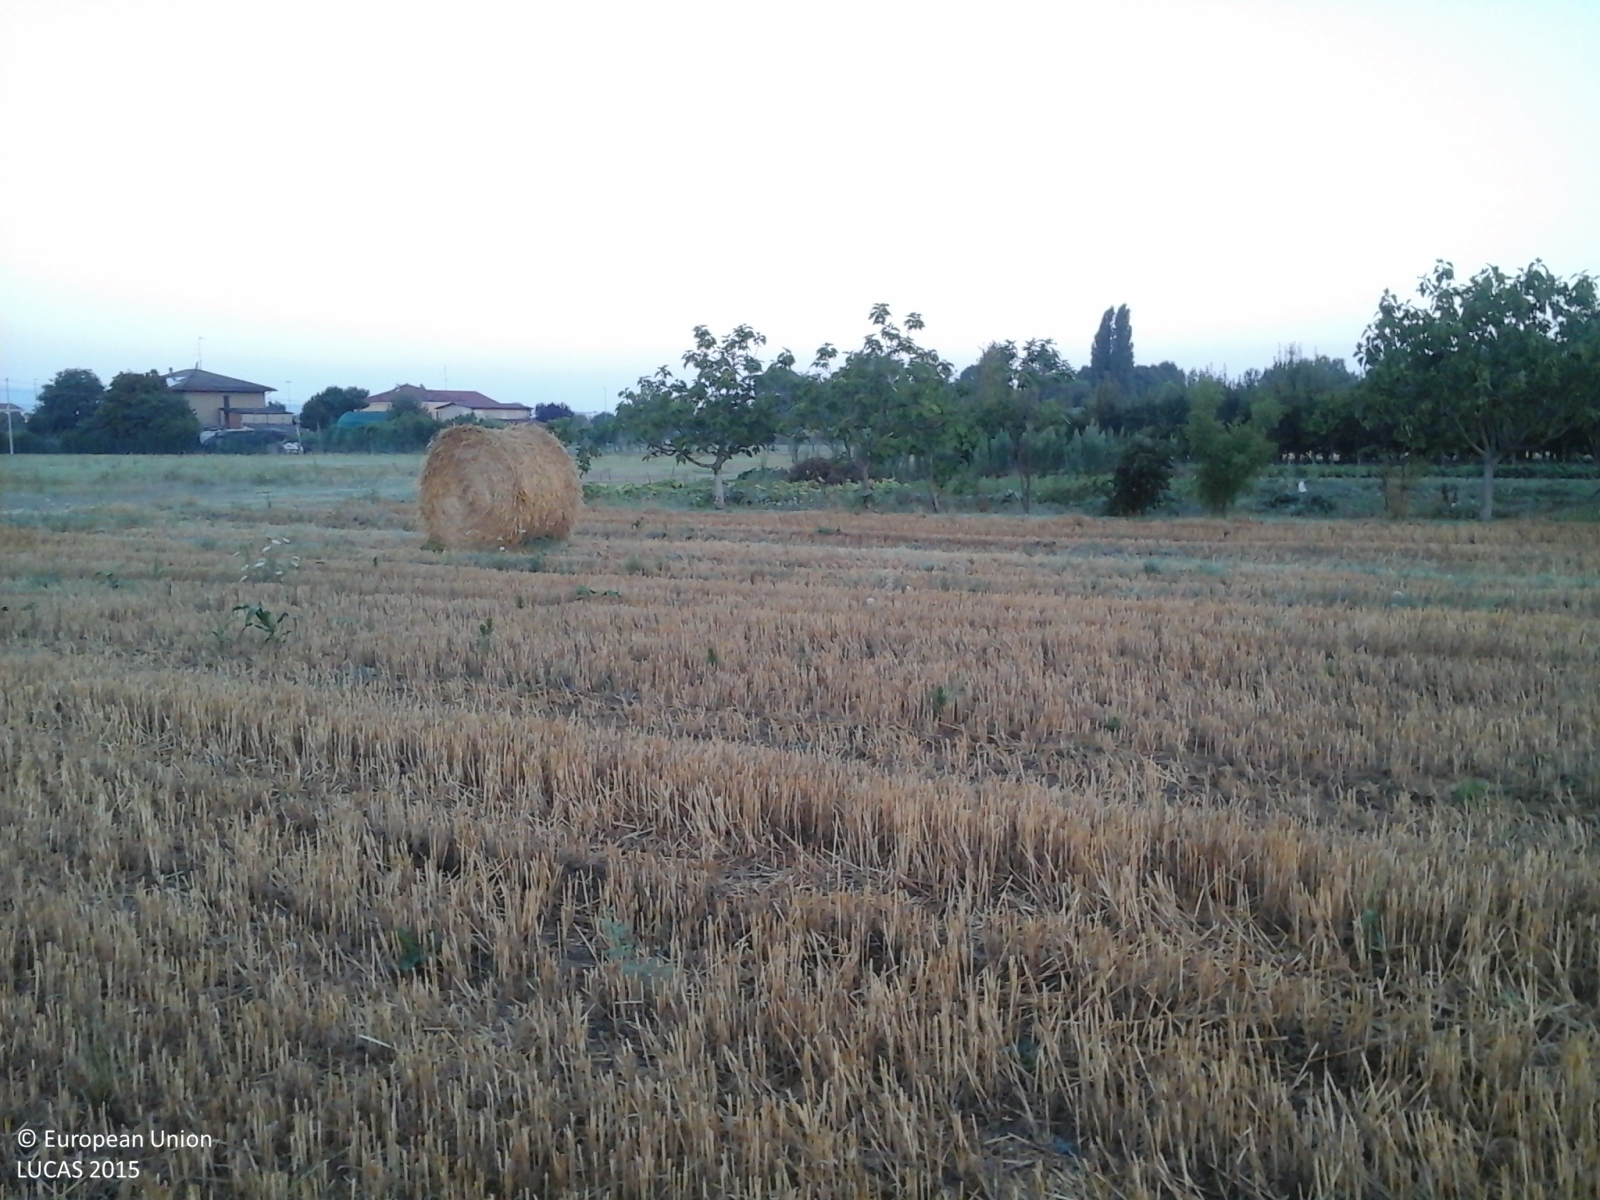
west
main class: Cropland
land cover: Common wheat
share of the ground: > 75 %
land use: Agriculture (excluding fallow land and kitchen gardens)
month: August
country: IT
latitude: 44.2409
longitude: 12.0114
